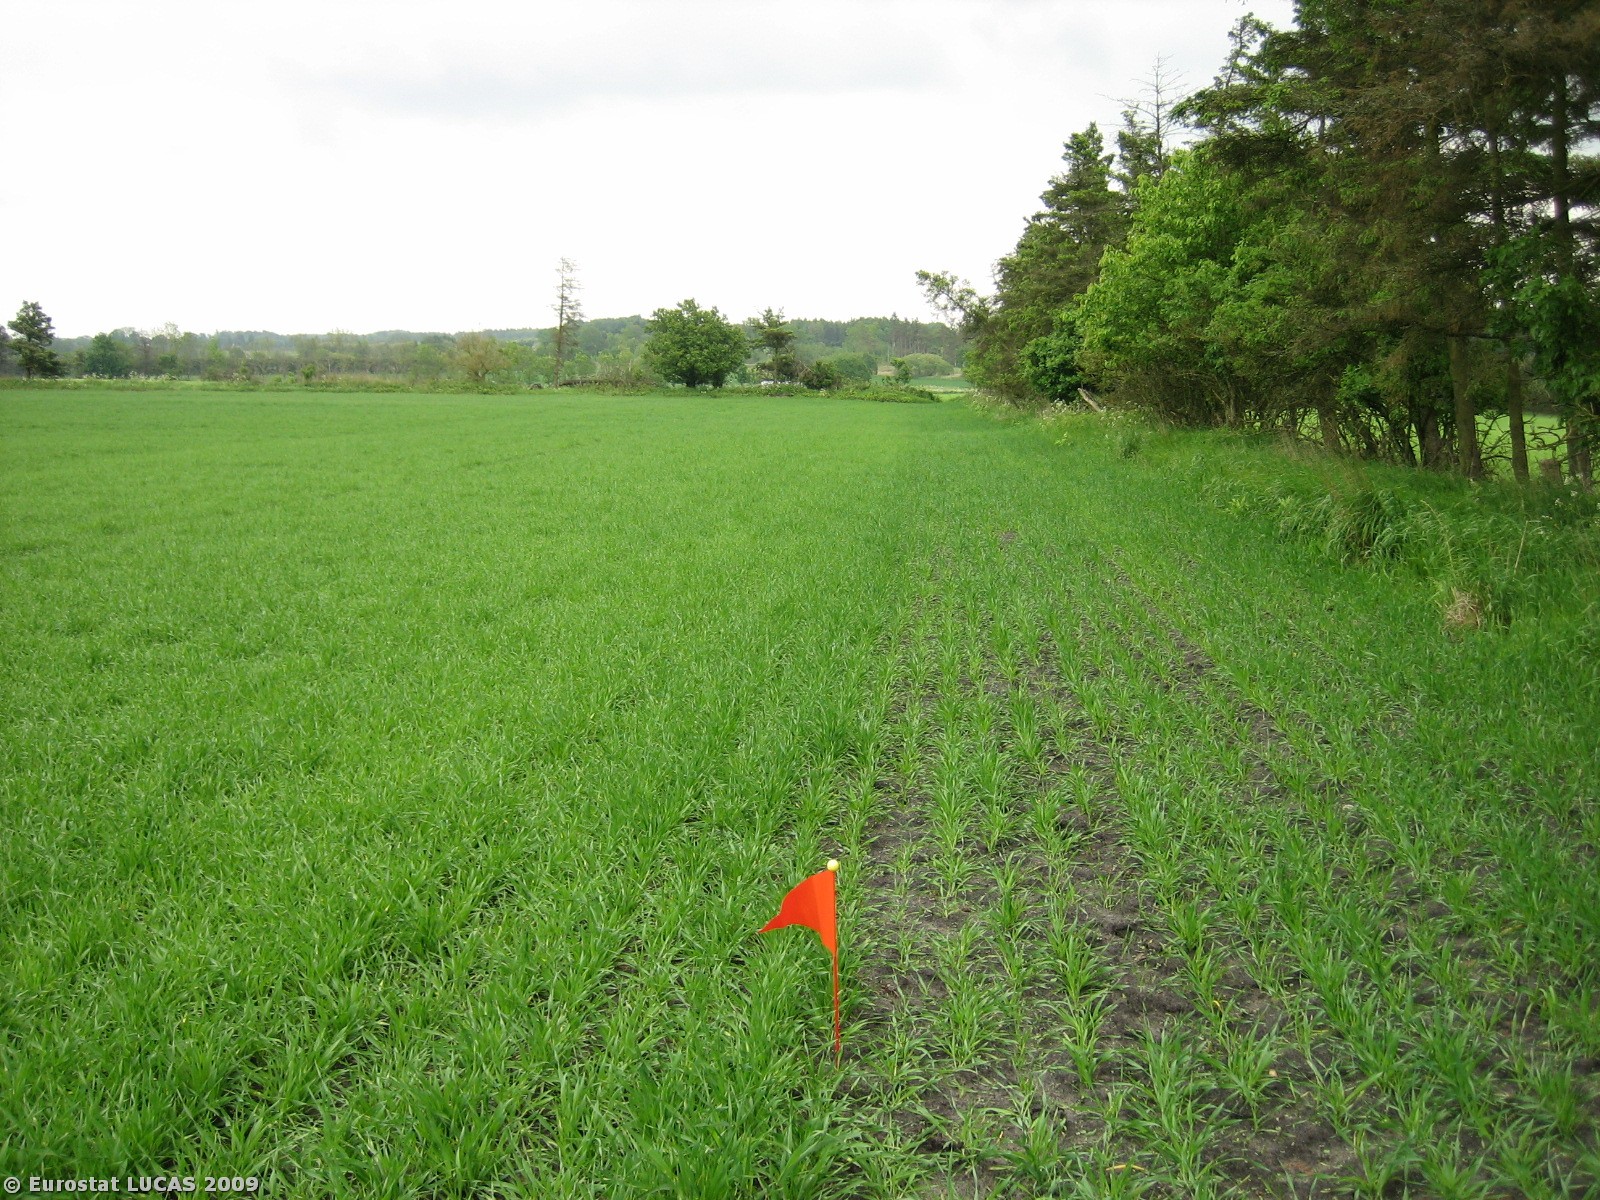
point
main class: Cropland
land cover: Barley
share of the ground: 50 - 75 %
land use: Agriculture (excluding fallow land and kitchen gardens)
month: May
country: DK
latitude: 55.7903
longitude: 9.2831
